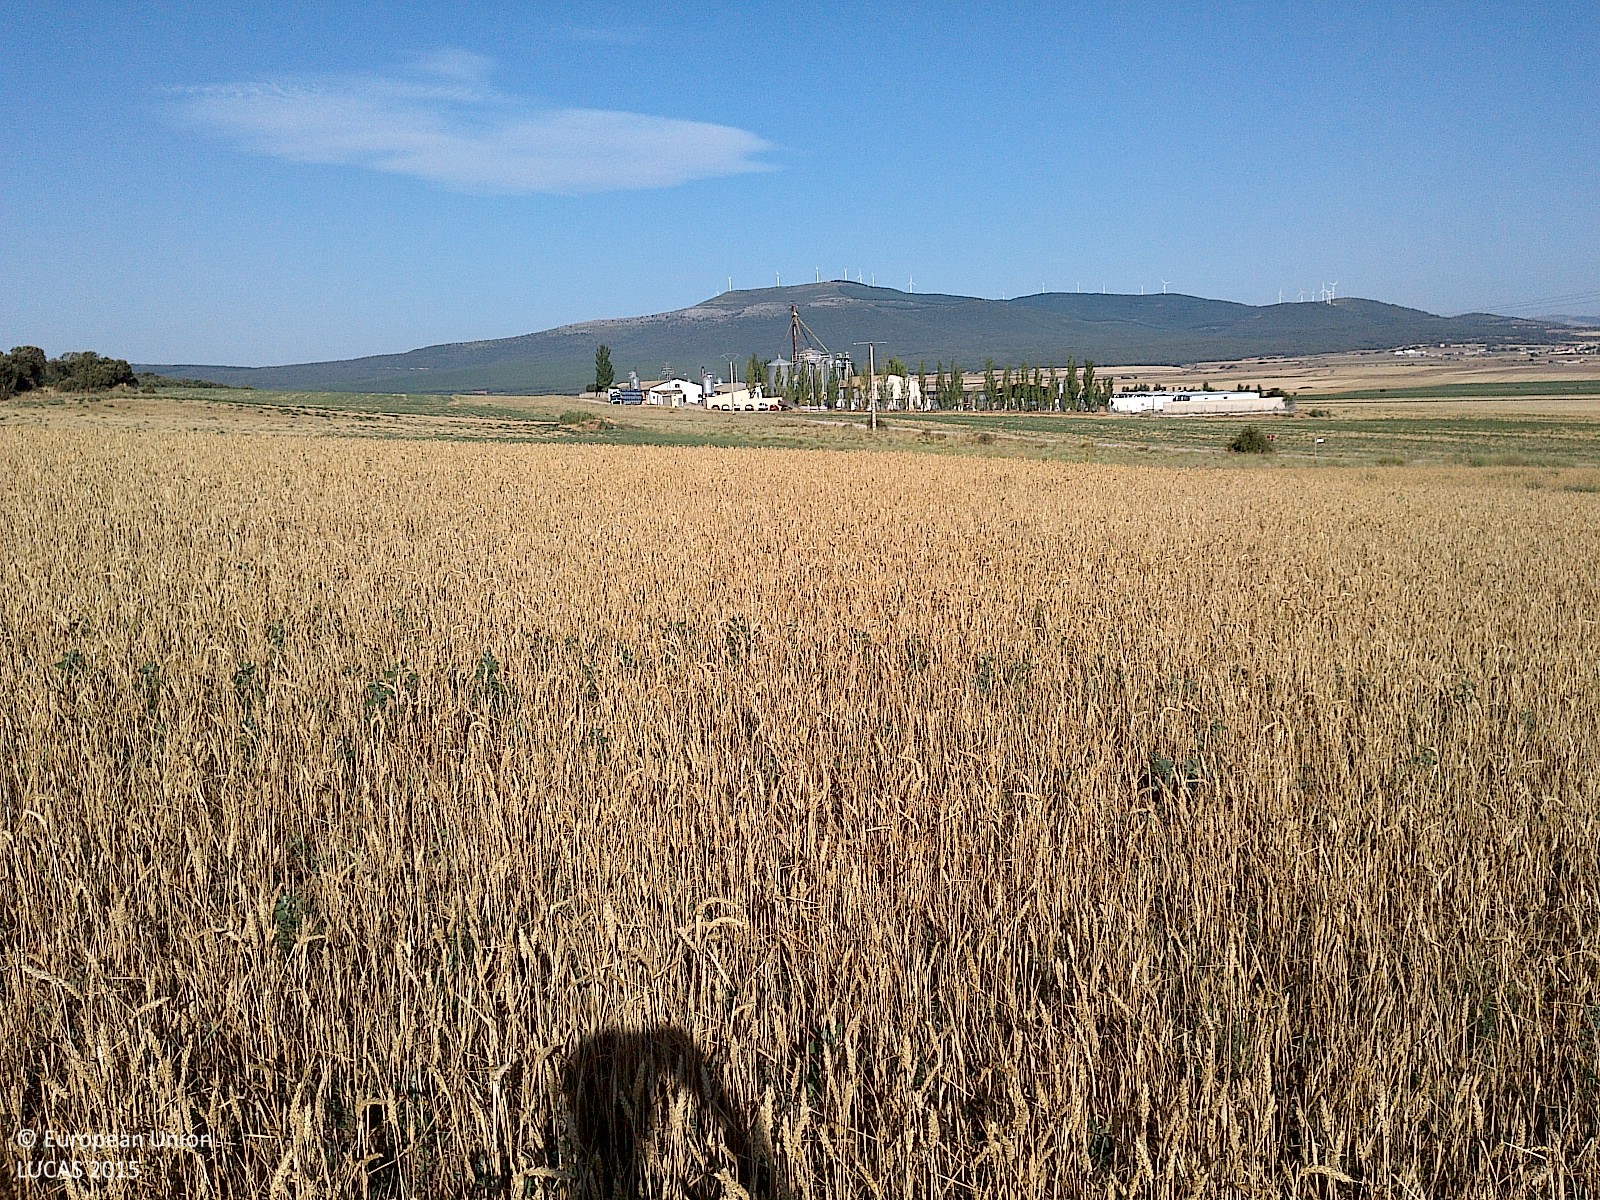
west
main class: Cropland
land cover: Common wheat
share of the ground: 50 - 75 %
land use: Agriculture (excluding fallow land and kitchen gardens)
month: July
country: ES
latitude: 41.8268
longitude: -2.0136
